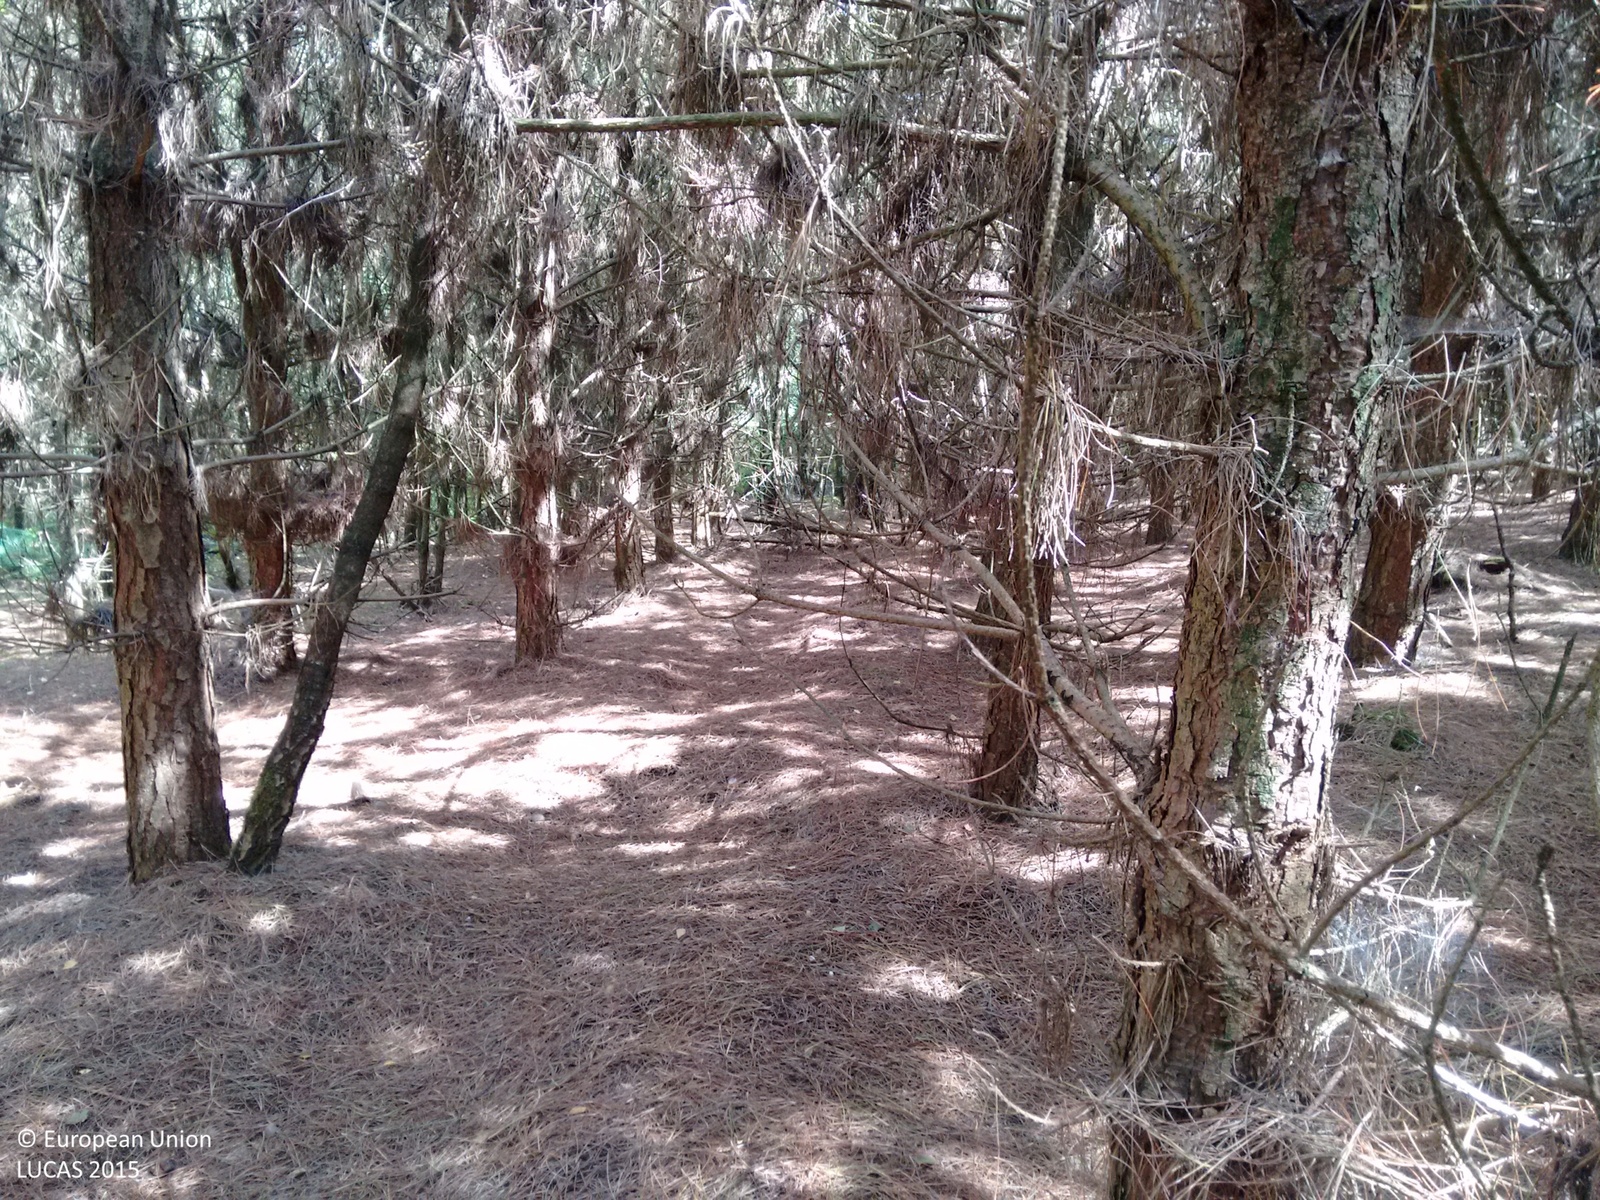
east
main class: Woodland
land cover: Pine dominated coniferous woodland
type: exotic forest
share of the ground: > 75 %
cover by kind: coniferous forest trees 100 %
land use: Forestry
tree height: > 5 m
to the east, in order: Pine dominated coniferous woodland; Grass margins; Tracks; Grass margins; Spruce dominated coniferous woodland; Broadleaved woodland; Shrubland with sparse tree cover; Other mixed woodland; Tracks; Grass margins; Pine dominated coniferous woodland
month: August
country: GB
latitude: 52.7437
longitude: -2.0425
